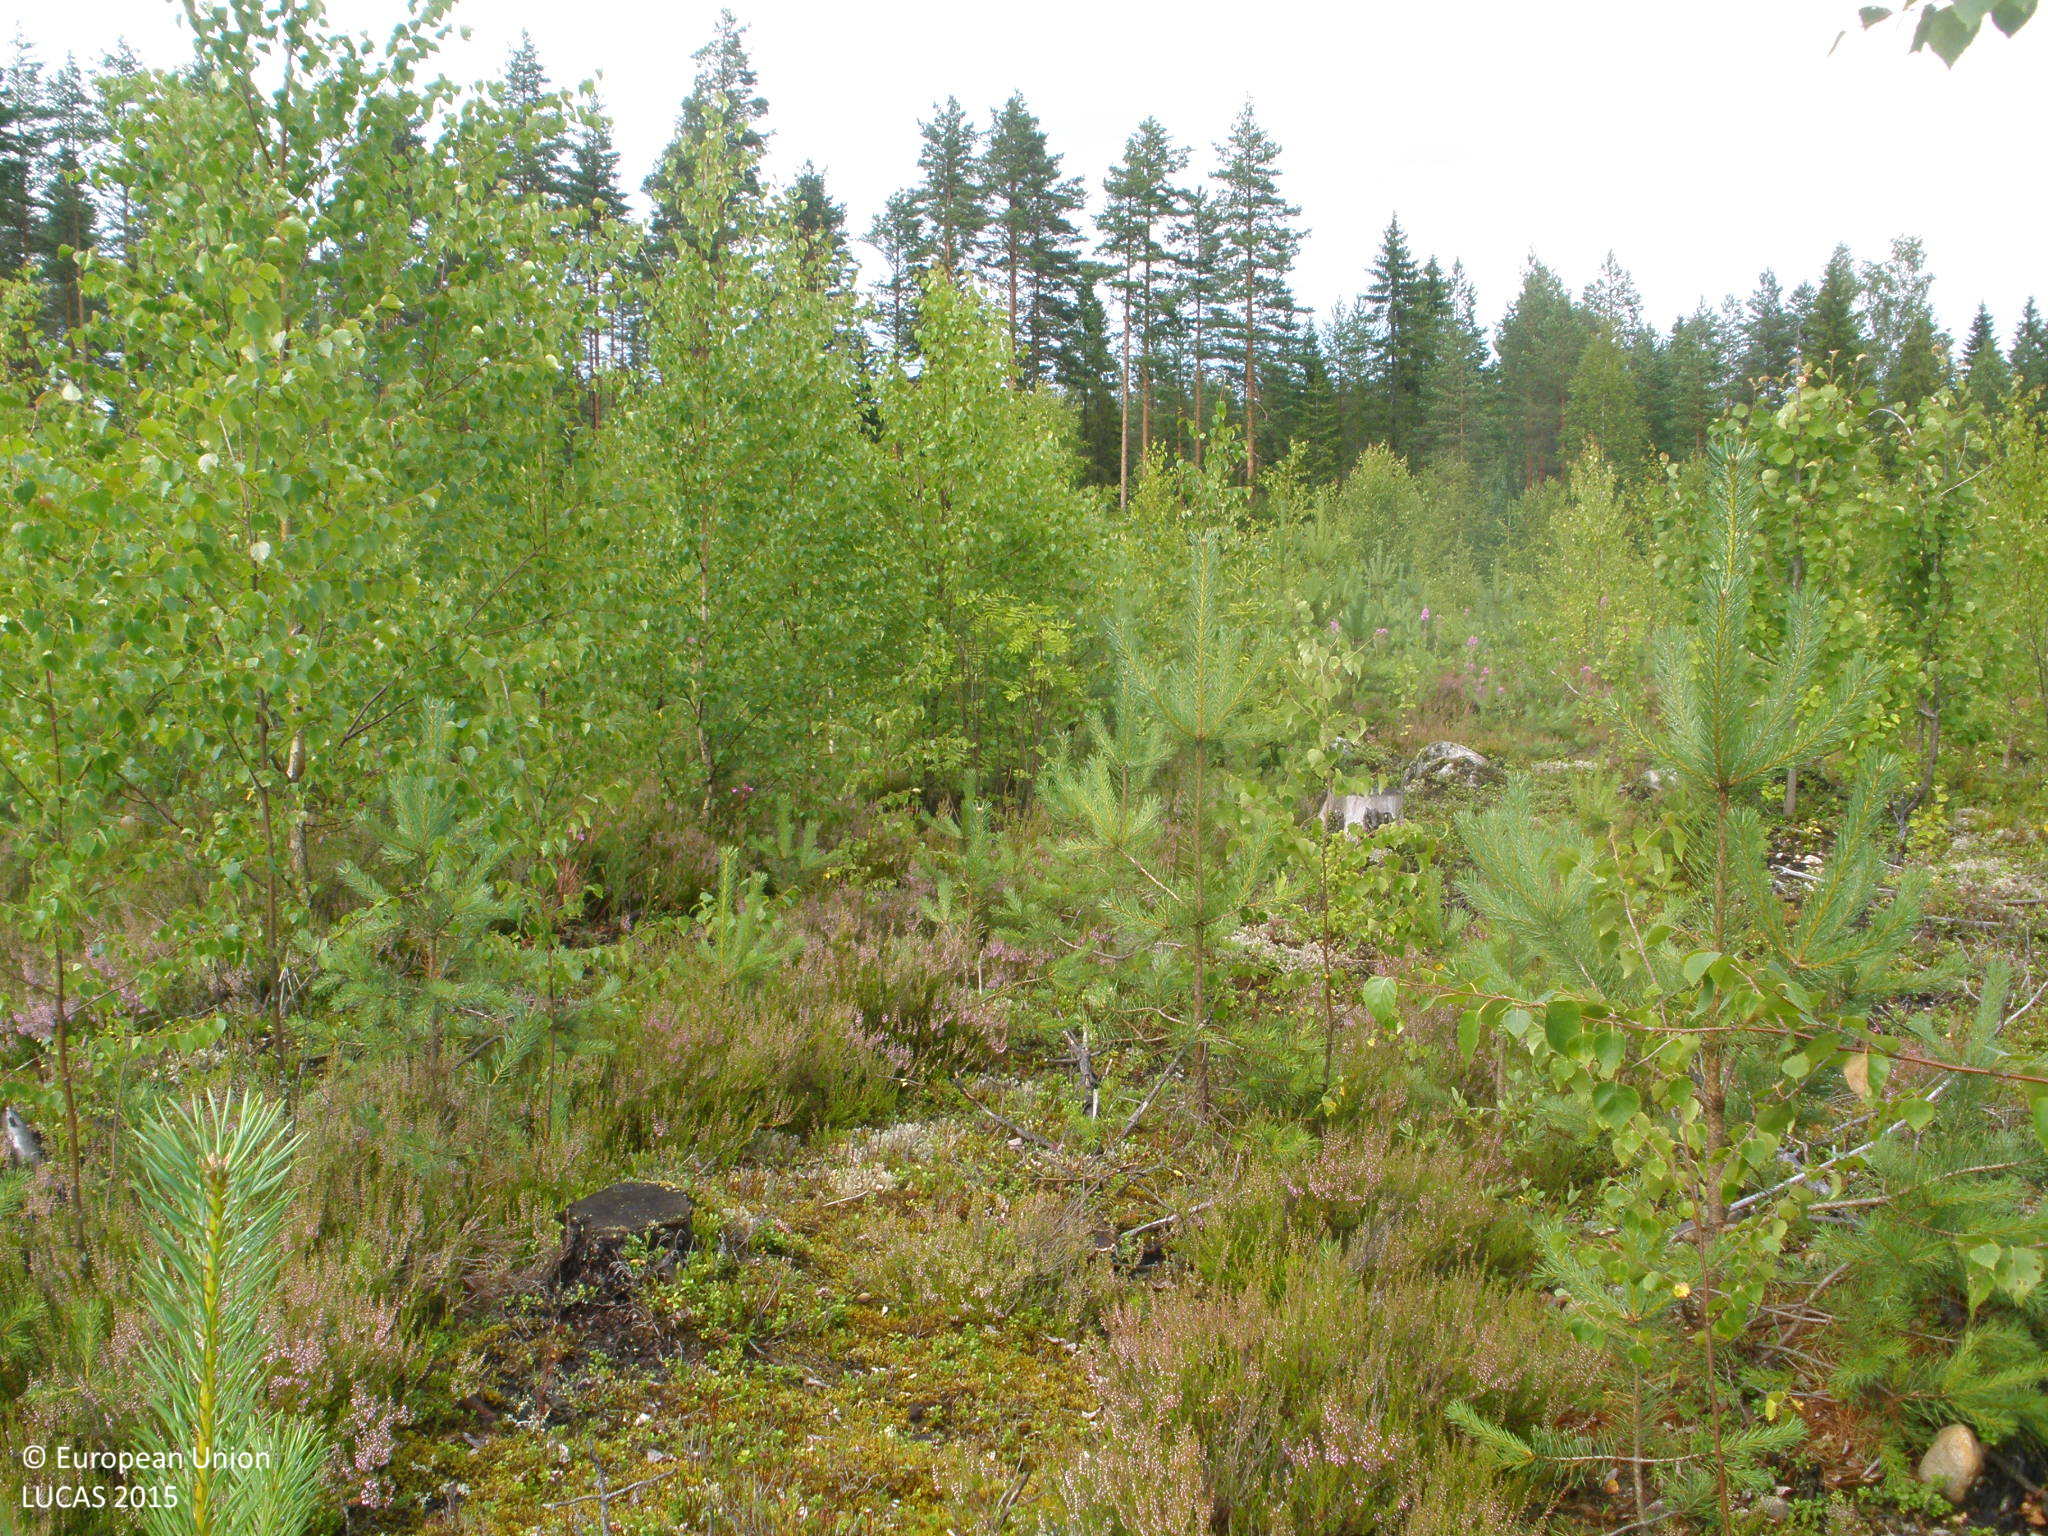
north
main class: Woodland
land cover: Pine dominated mixed woodland
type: boreal forest
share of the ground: 25 - 50 %
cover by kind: lichens and mosses 30 %, broadleaved forest trees 25 %, coniferous forest trees 20 %, shrubs 10 %, herbaceous plants 10 %, unconsolidated bare surface 5 %
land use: Forestry
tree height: < 5 m
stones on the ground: 10 - 25 %
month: July
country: FI
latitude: 61.2208
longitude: 24.7224
